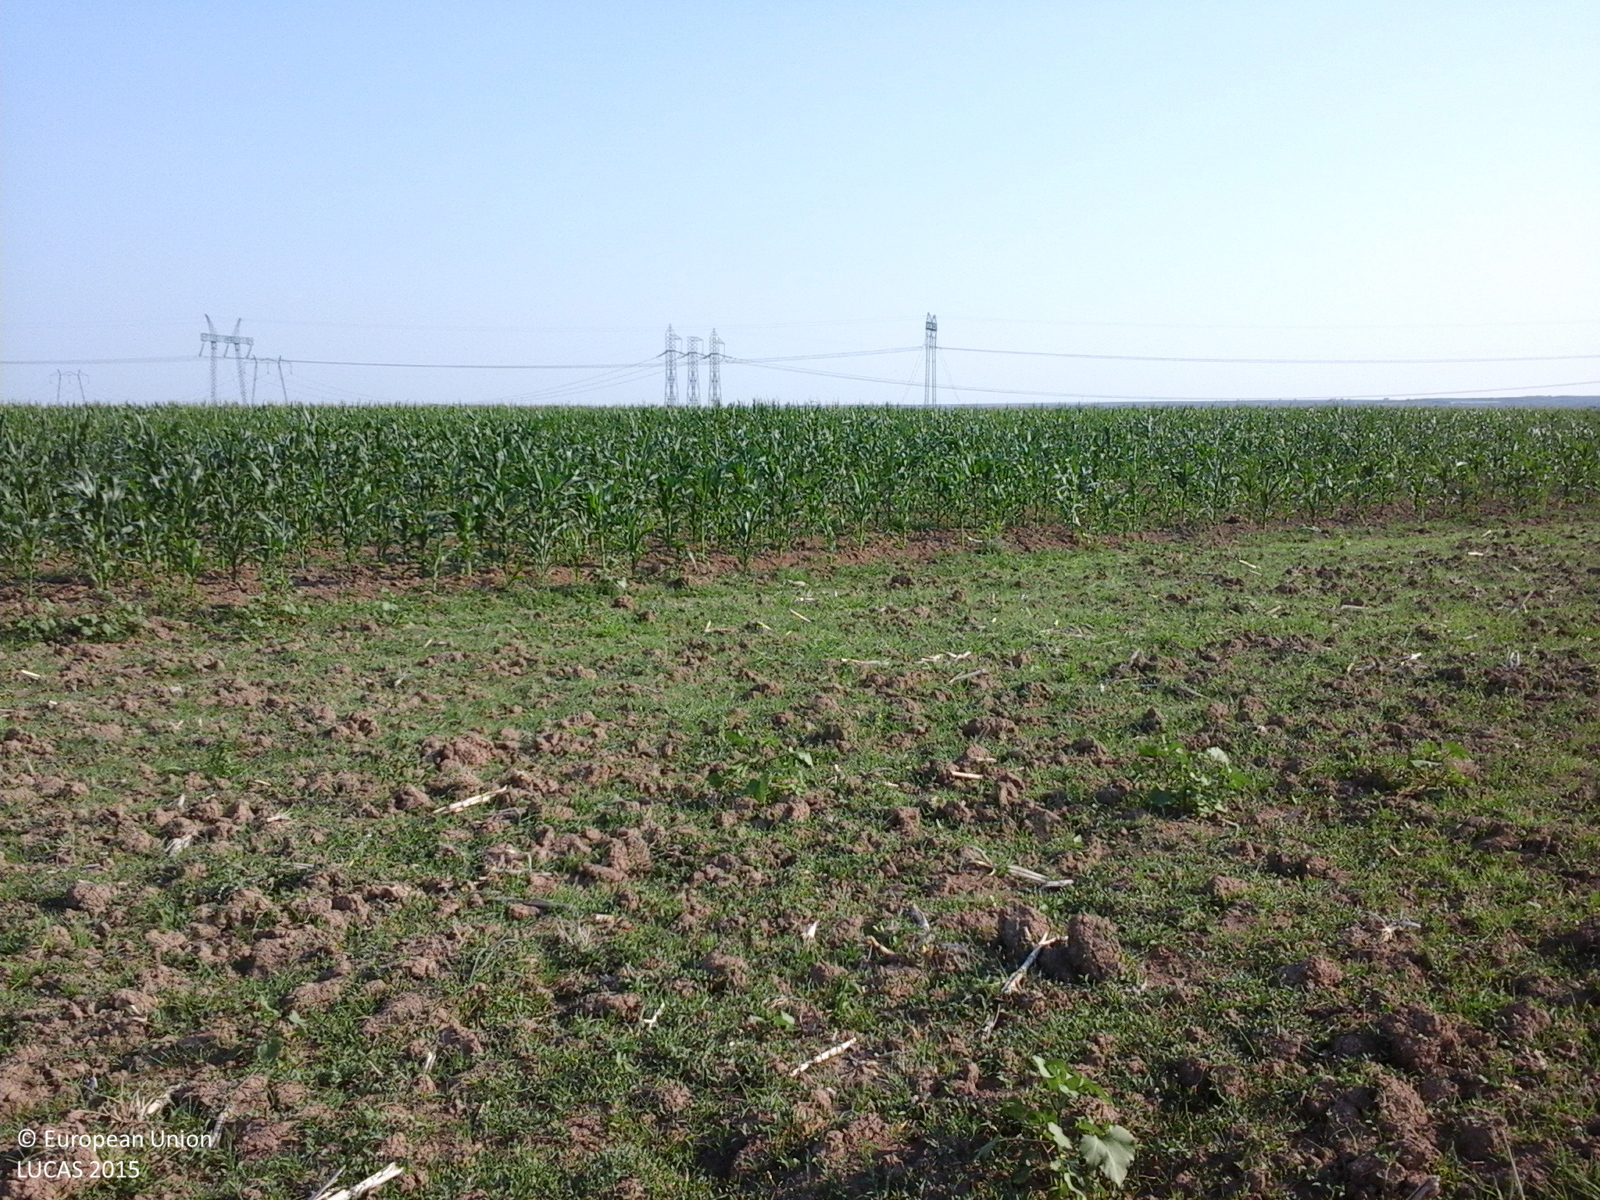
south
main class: Grassland
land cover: Spontaneously vegetated surfaces
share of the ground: 25 - 50 %
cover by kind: herbaceous plants 100 %
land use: Fallow land
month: July
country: RO
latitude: 44.7093
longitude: 24.6804
